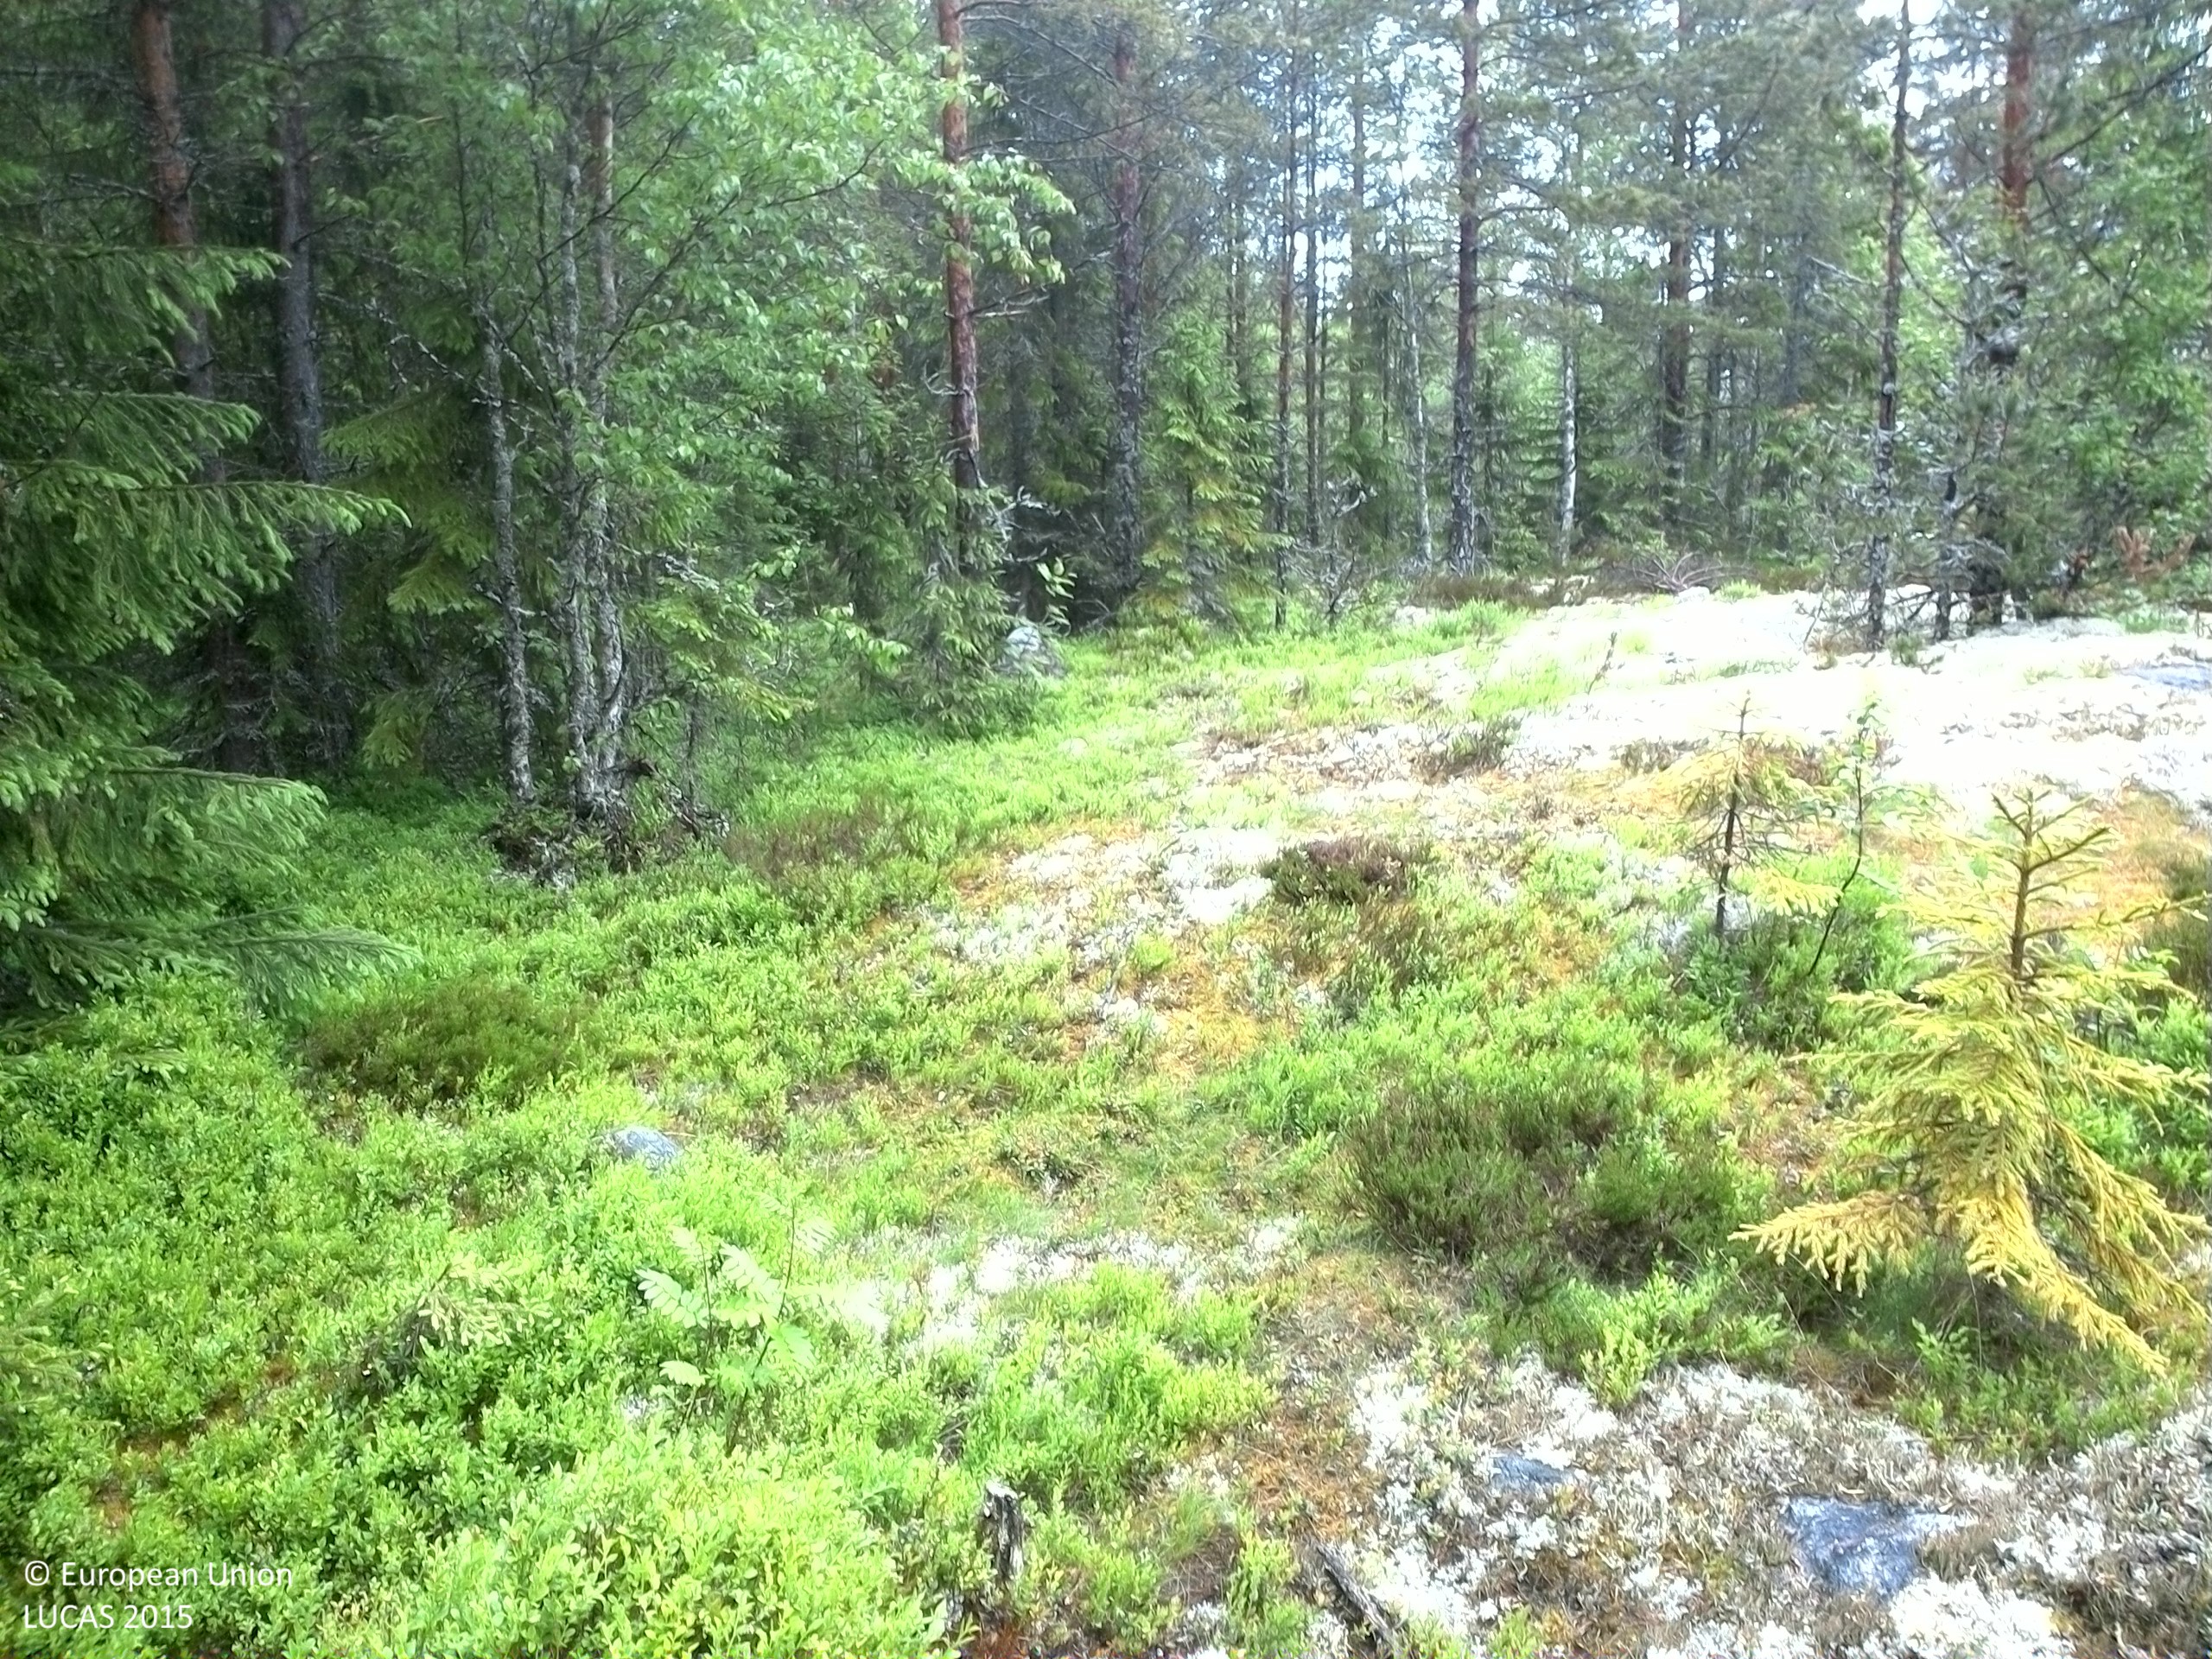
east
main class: Woodland
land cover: Spruce dominated mixed woodland
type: boreal forest
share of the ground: > 75 %
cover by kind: coniferous forest trees 50 %, broadleaved forest trees 30 %, shrubs 20 %
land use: Forestry
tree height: > 5 m
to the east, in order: Spruce dominated mixed woodland; Pine dominated coniferous woodland; Pine dominated mixed woodland; Pine dominated coniferous woodland
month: June
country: SE
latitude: 62.7469
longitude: 17.9464
